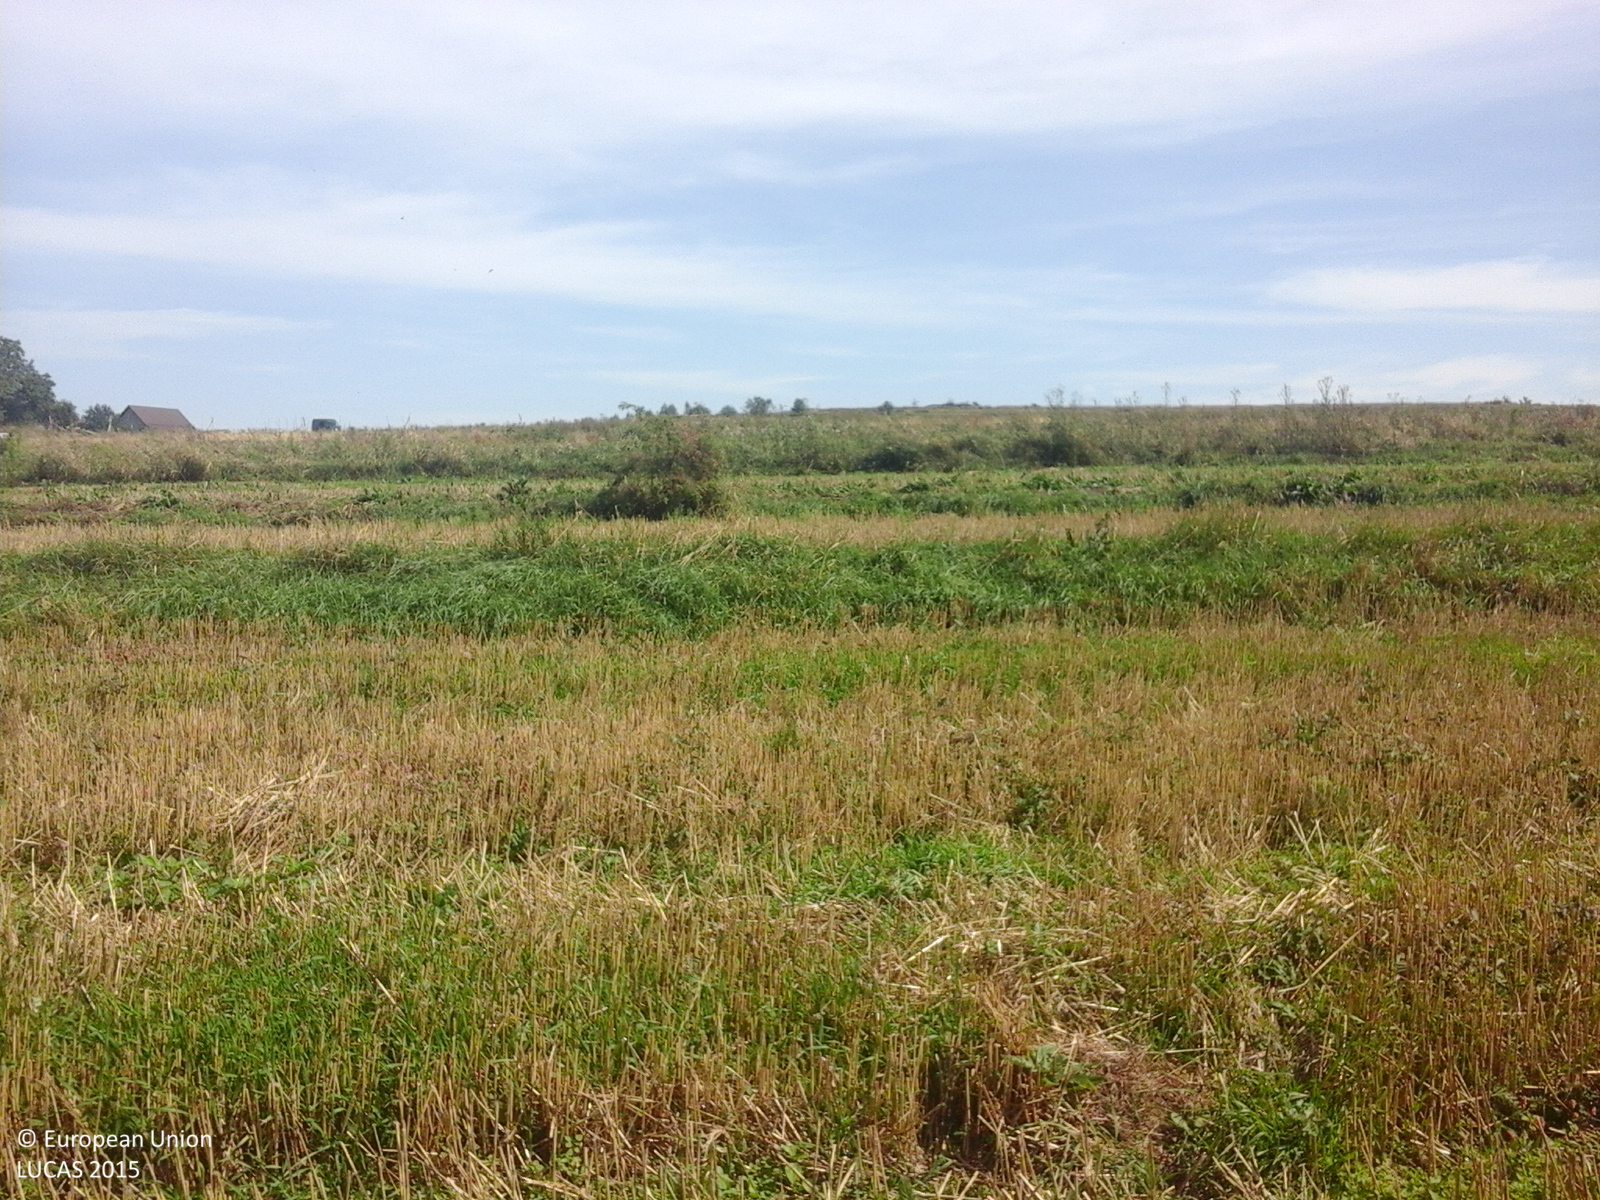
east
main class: Cropland
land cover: Potatoes
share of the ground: > 75 %
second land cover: Spontaneously vegetated surfaces
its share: 25 - 50 %
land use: Agriculture (excluding fallow land and kitchen gardens)
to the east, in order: Potatoes; Spontaneously vegetated surfaces; Grass margins; Common wheat; Grass margins; Common wheat; Grass margins; Common wheat; Grass margins; Other root crops; Potatoes; Grass margins; Potatoes; Grass margins; Common wheat; Grass margins; Other bare soil; Grass margins; Common wheat; Spontaneously vegetated surfaces; Other bare soil; Potatoes; Grass margins; Tracks; Grassland without tree/shrub cover; Other bare soil; Grass margins; Potatoes; Grass margins; Grassland without tree/shrub cover; Grass margins; Potatoes; Grassland without tree/shrub cover; Other bare soil; Grass margins; Potatoes; Grass margins; Potatoes
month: September
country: RO
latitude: 46.7516
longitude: 23.1940
